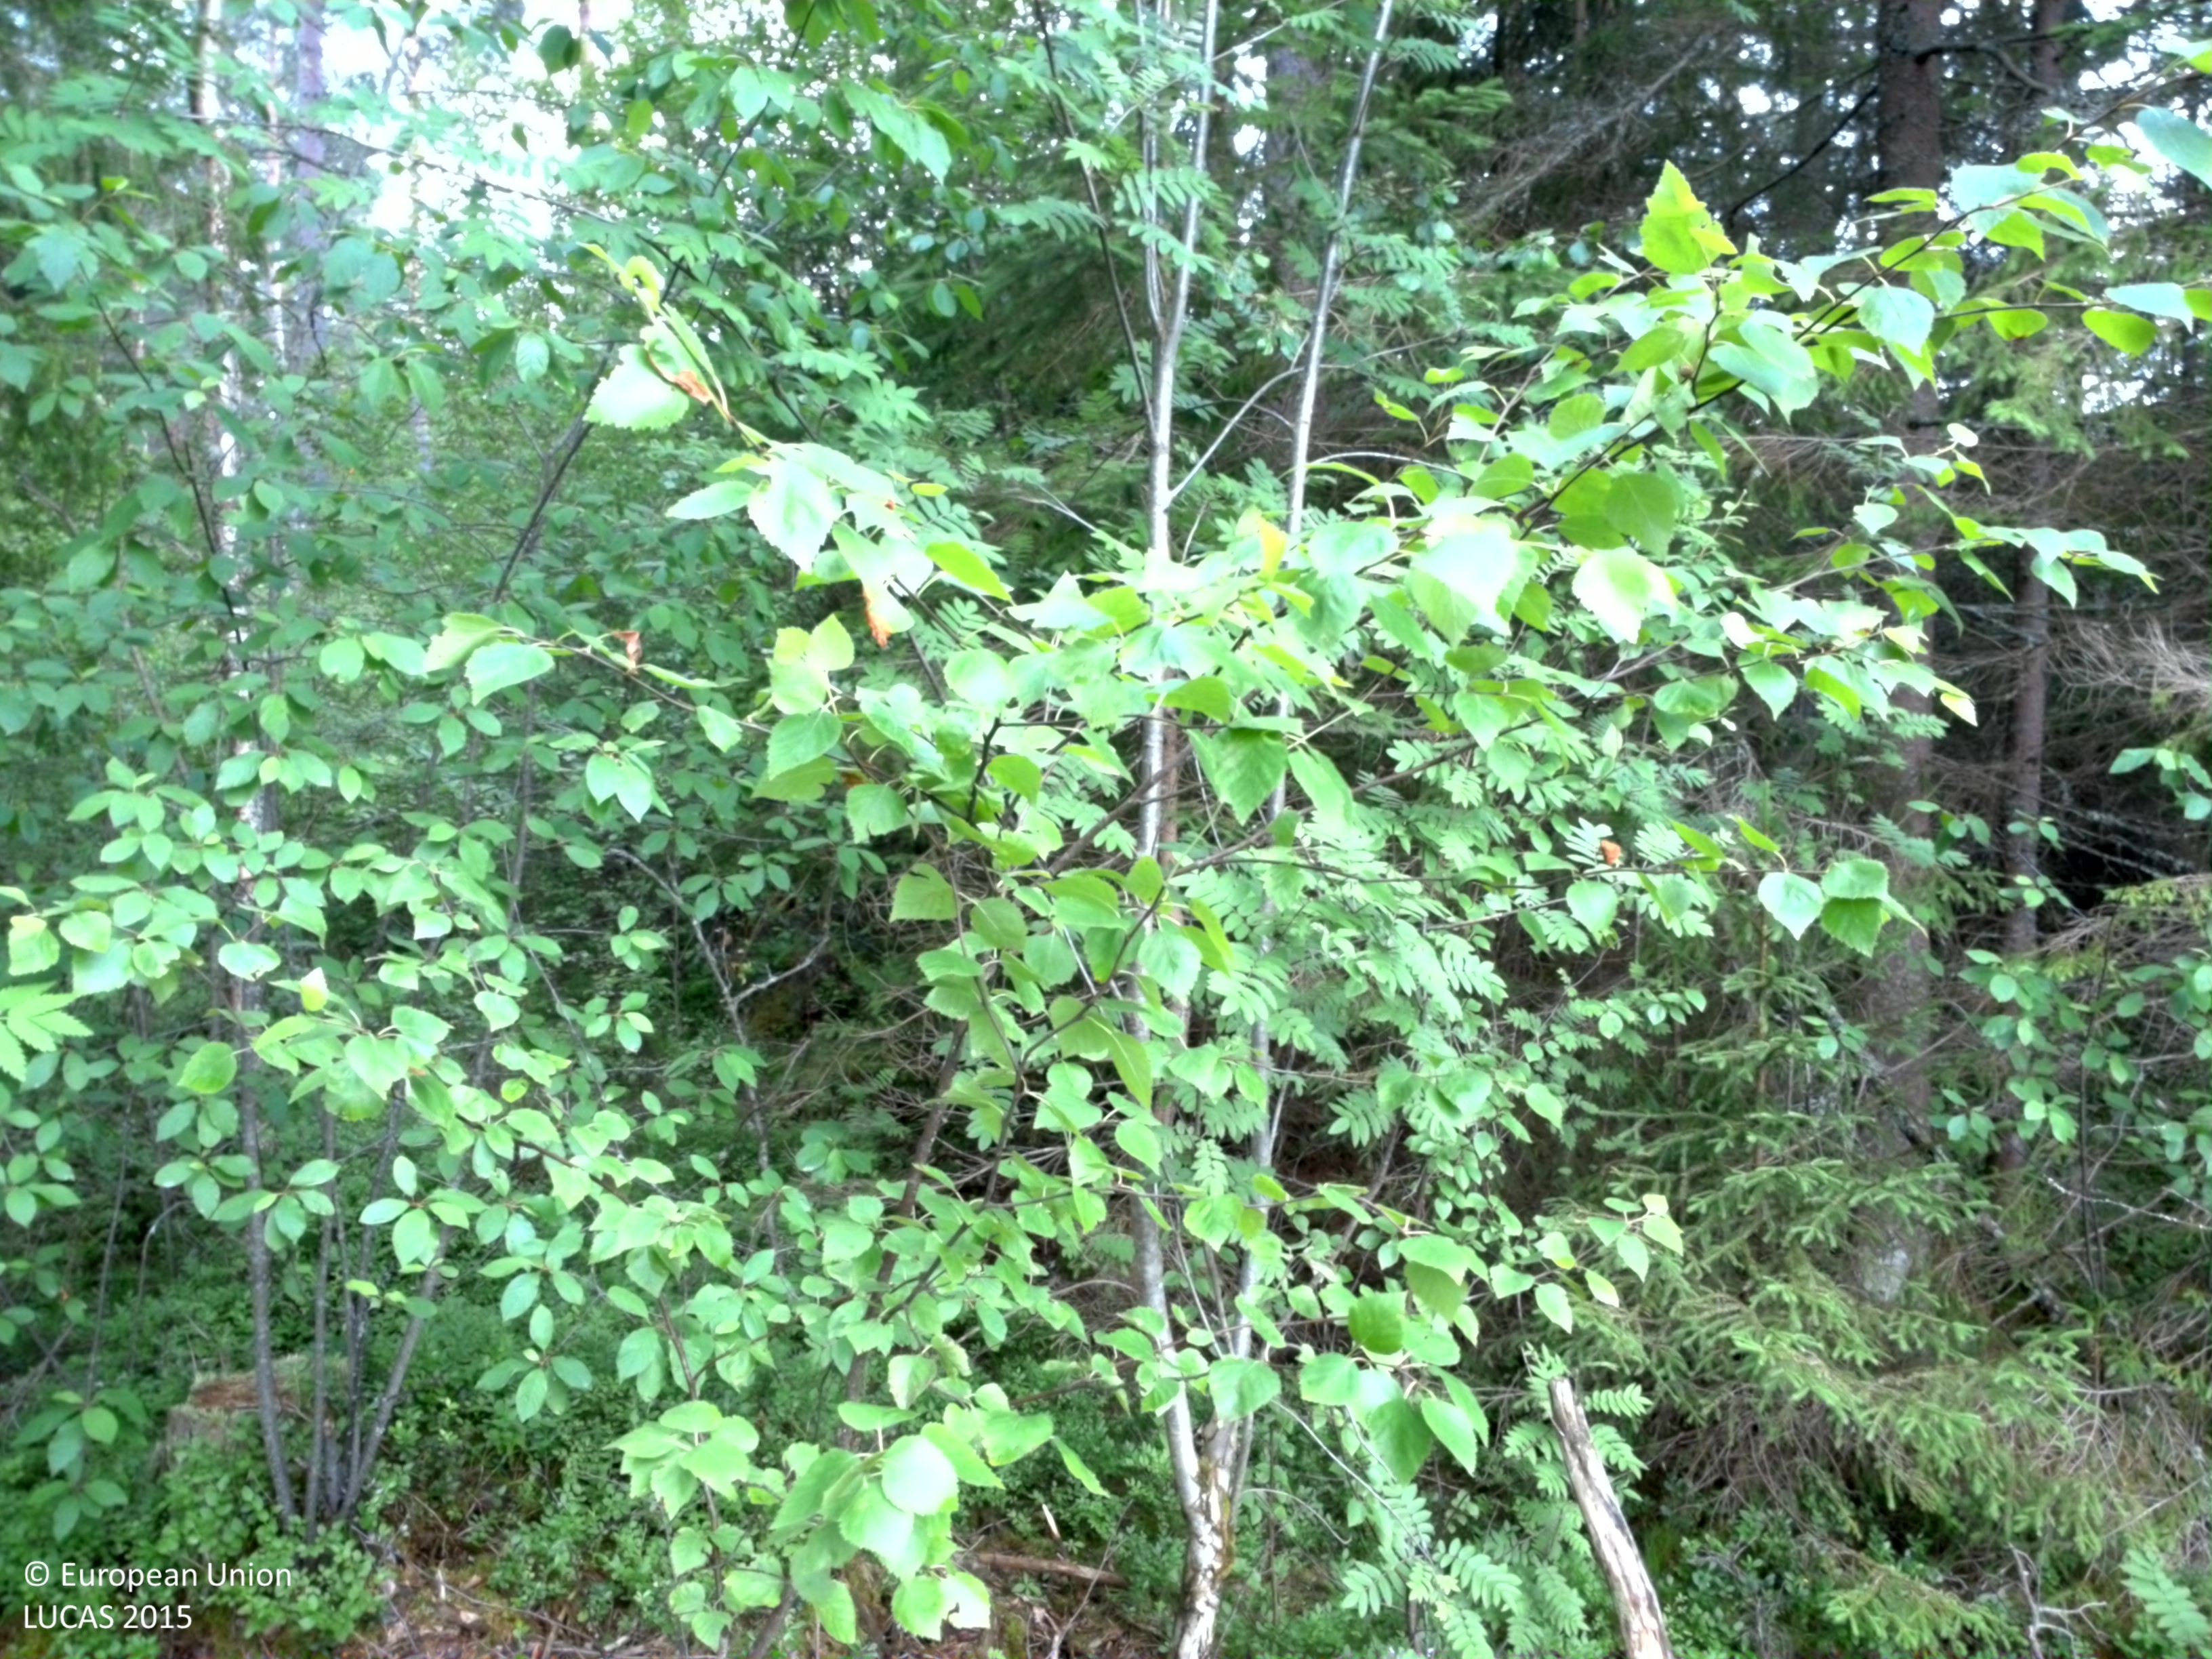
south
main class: Woodland
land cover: Other mixed woodland
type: boreal forest
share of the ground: 50 - 75 %
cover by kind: coniferous forest trees 40 %, shrubs 30 %, broadleaved forest trees 25 %, lichens and mosses 5 %
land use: Forestry
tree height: > 5 m
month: July
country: SE
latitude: 58.7411
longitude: 14.4333
